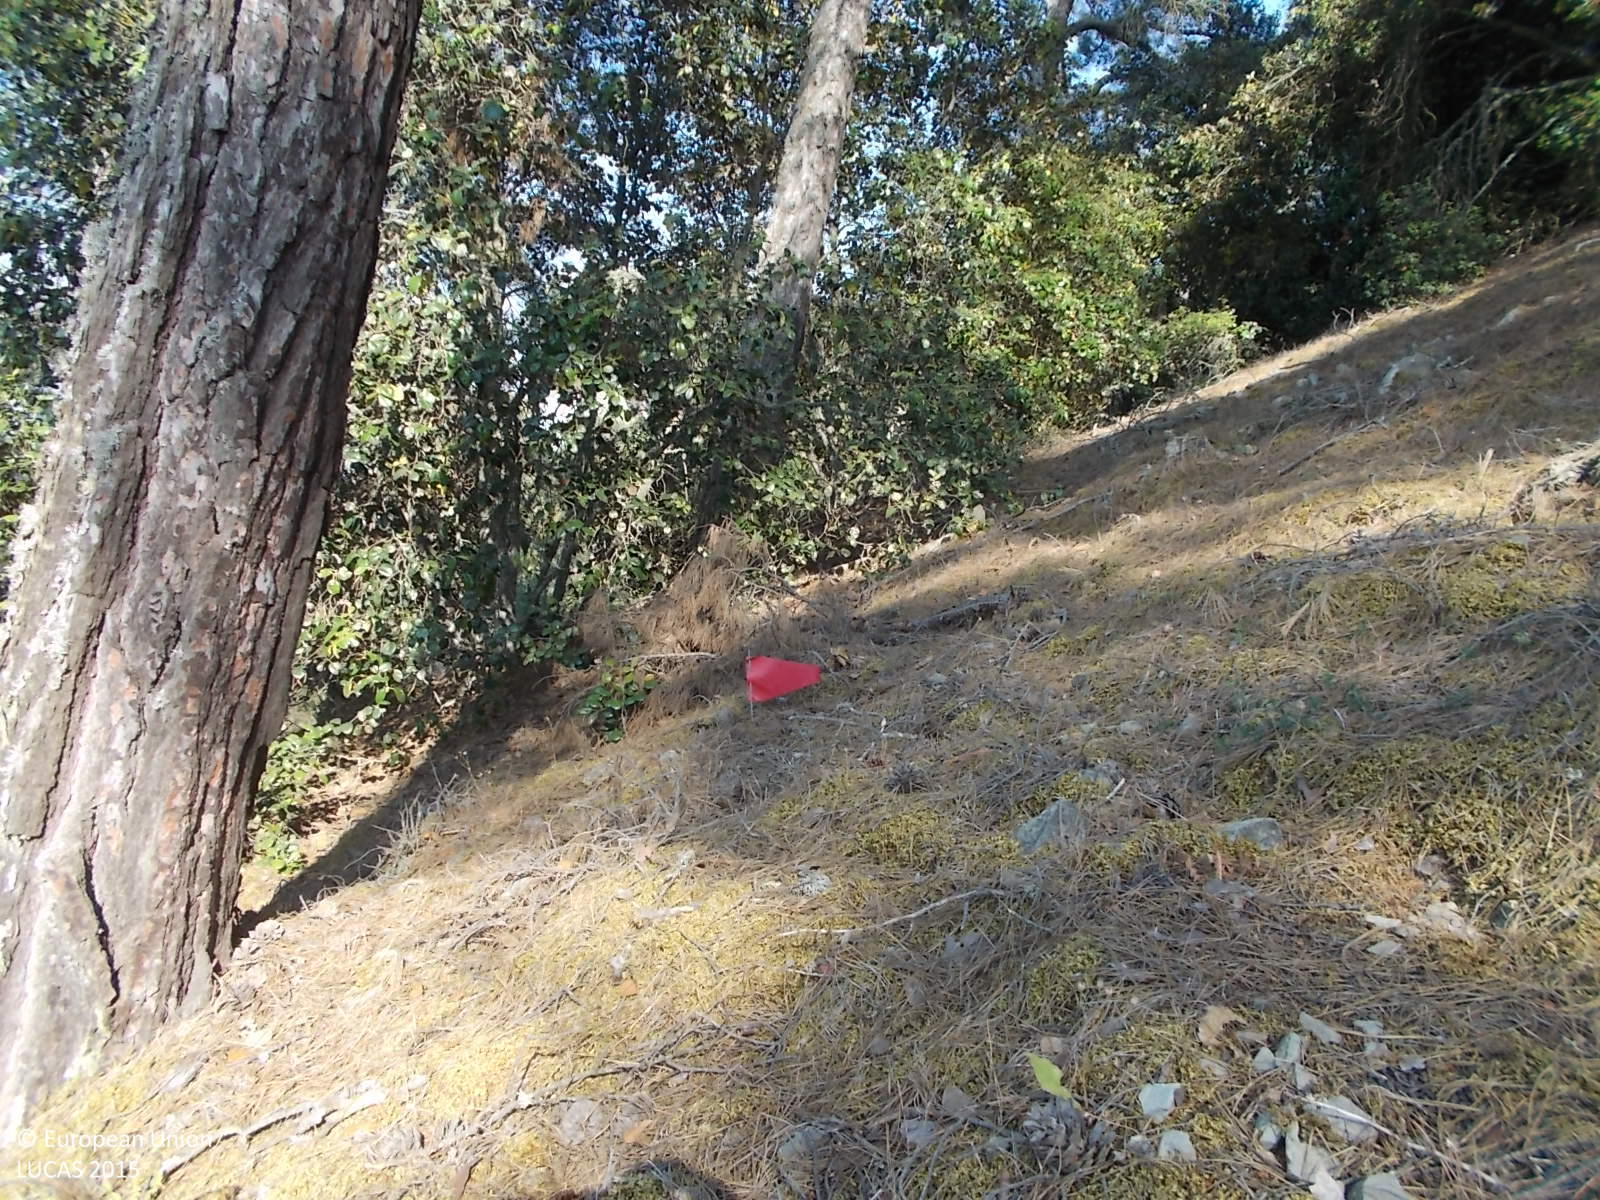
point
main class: Woodland
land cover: Pine dominated mixed woodland
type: coniferous forest of the mediterranean region
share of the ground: > 75 %
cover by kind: coniferous forest trees 70 %, broadleaved forest trees 25 %, unconsolidated bare surface 5 %
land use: Semi-natural and natural areas not in use
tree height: > 5 m
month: June
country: CY
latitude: 35.0623
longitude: 32.6064
